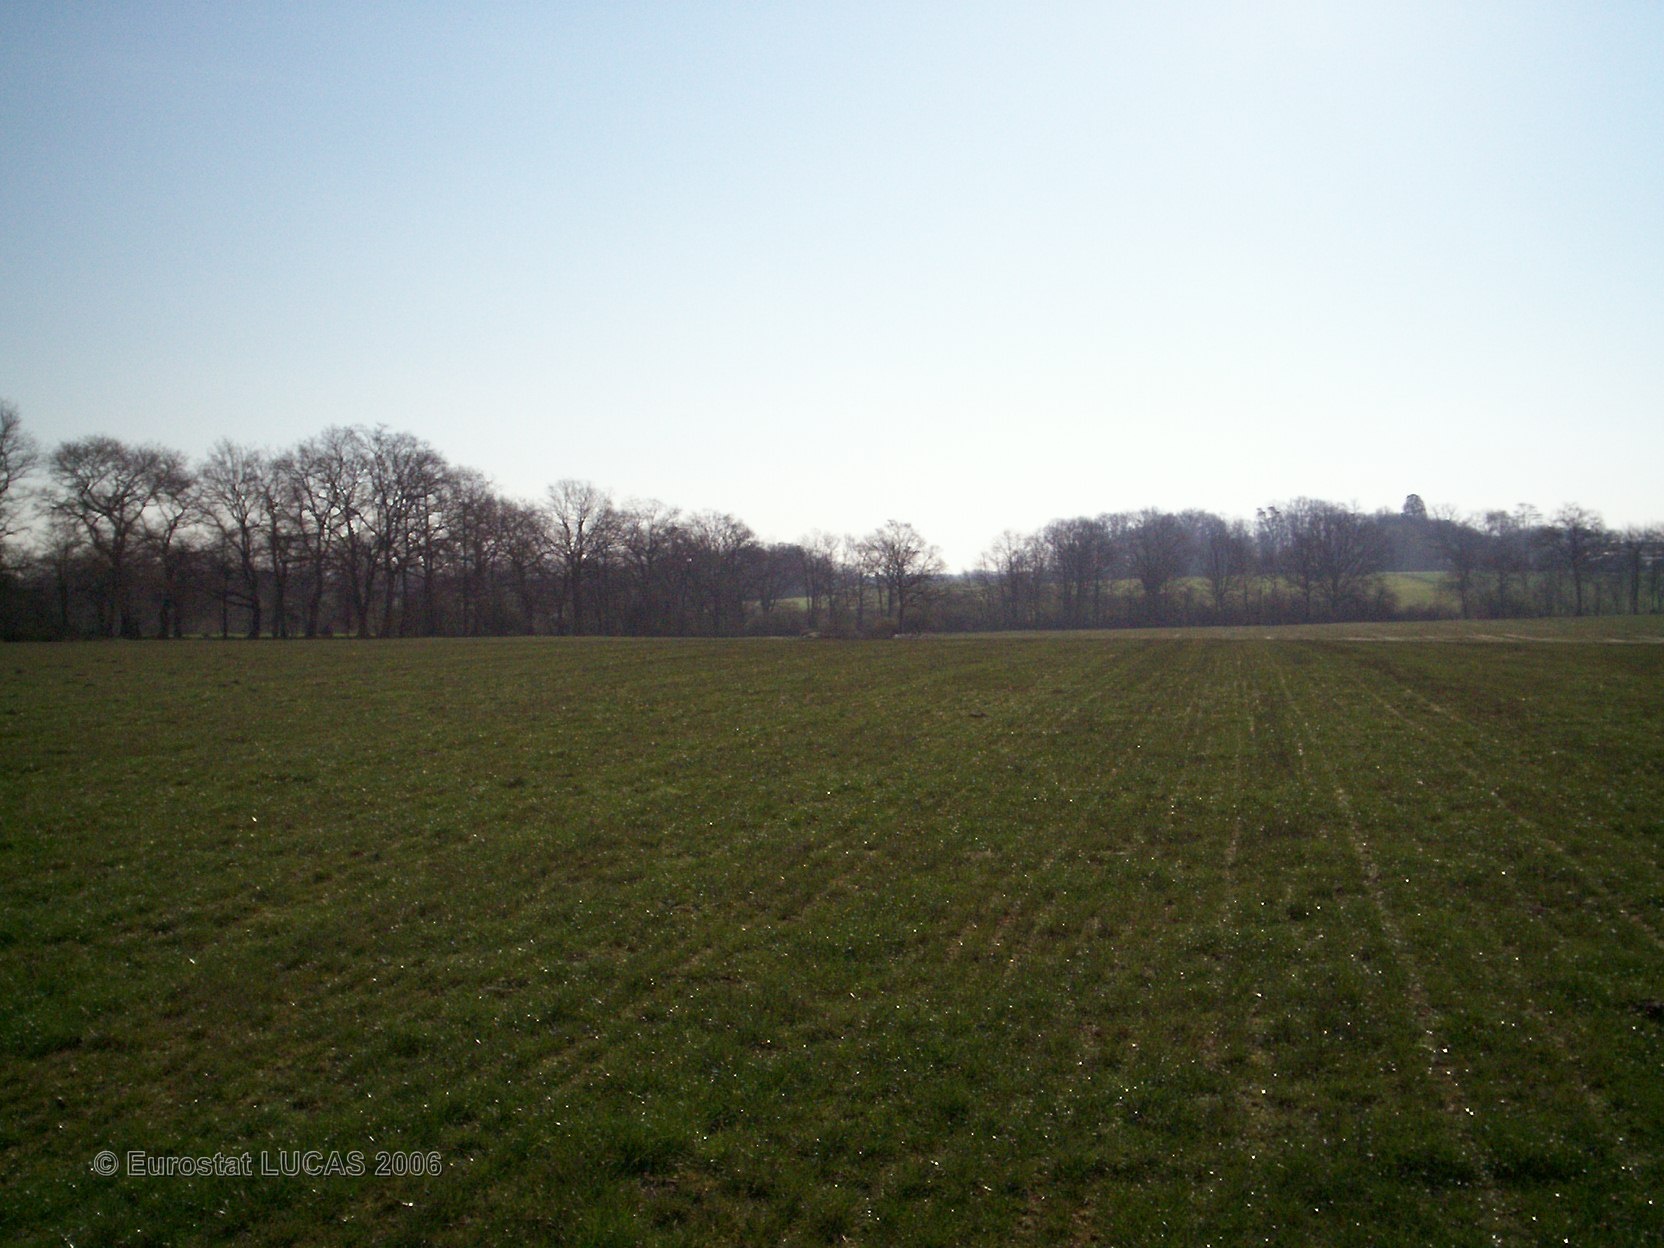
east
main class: Grassland
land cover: Grassland without tree/shrub cover
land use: Agriculture (excluding fallow land and kitchen gardens)
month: April
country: FR
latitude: 46.3230
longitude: 1.0908
